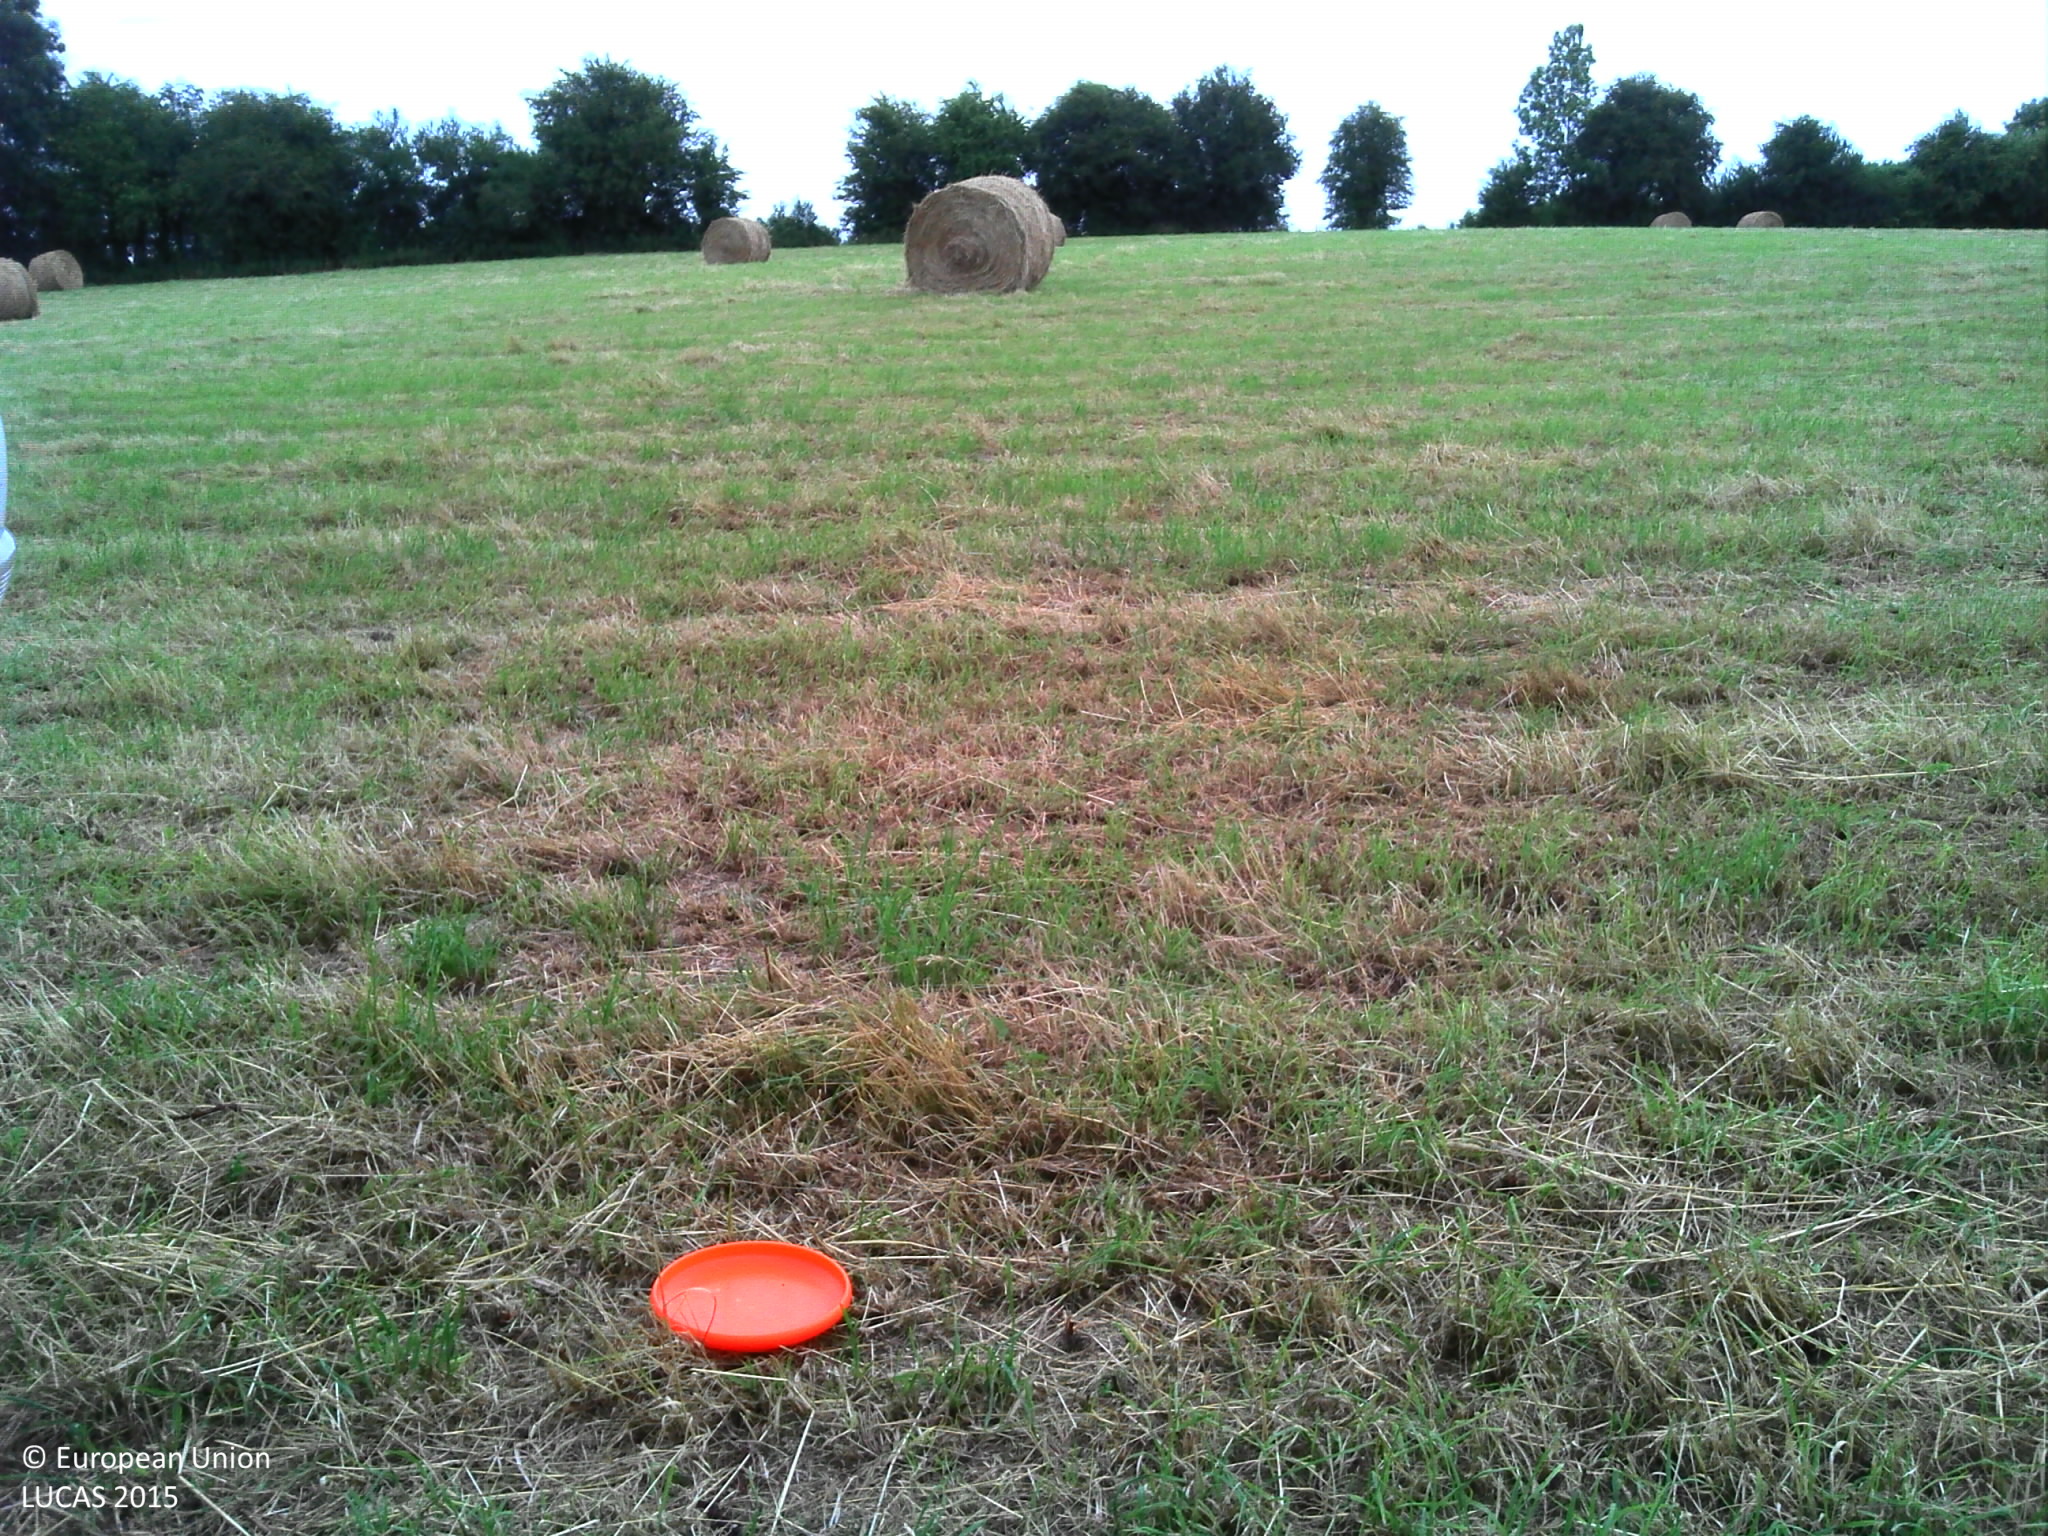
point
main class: Grassland
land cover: Grassland without tree/shrub cover
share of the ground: > 75 %
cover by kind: herbaceous plants 100 %
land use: Agriculture (excluding fallow land and kitchen gardens)
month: July
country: FR
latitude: 50.4209
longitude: 2.1739
